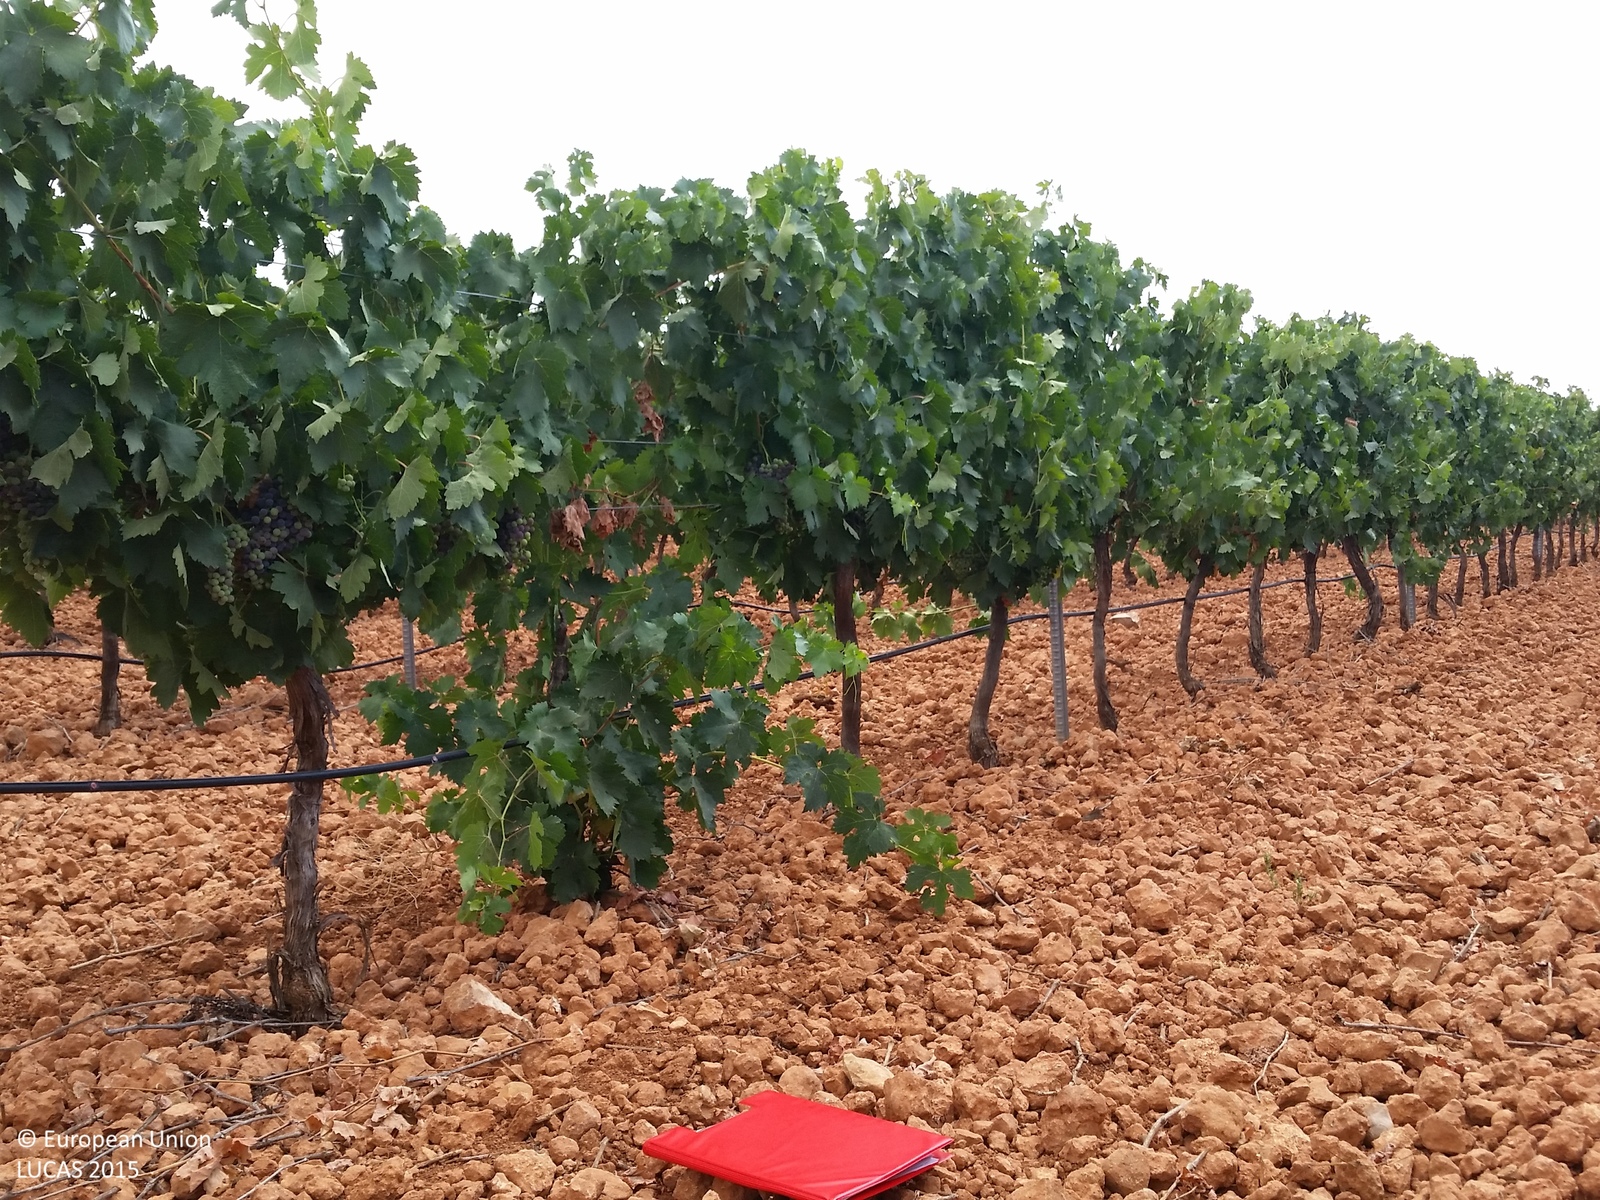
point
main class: Cropland
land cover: Vineyards
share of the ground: 50 - 75 %
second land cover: Other bare soil
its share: > 75 %
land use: Agriculture (excluding fallow land and kitchen gardens)
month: July
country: ES
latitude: 39.2257
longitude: -2.6476
